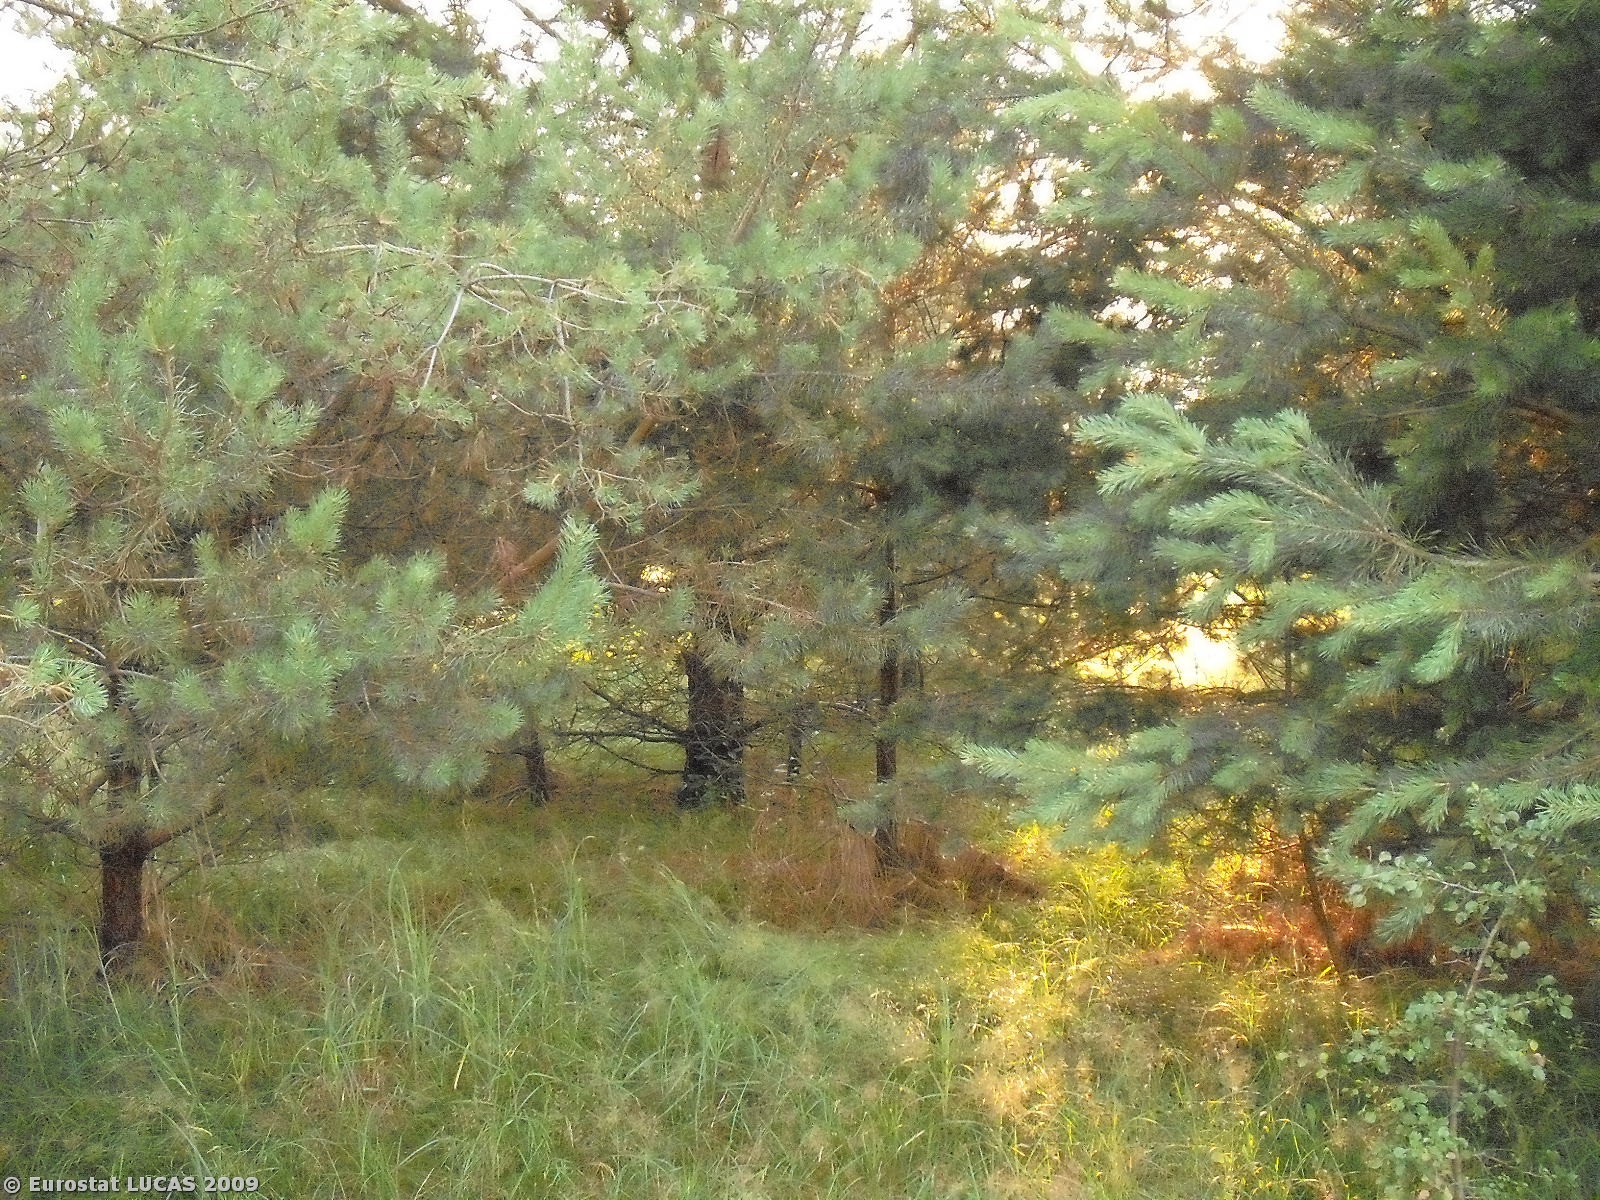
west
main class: Grassland
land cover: Grassland without tree/shrub cover
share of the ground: > 75 %
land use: Agriculture (excluding fallow land and kitchen gardens)
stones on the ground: < 10 %
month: July
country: PL
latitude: 51.0475
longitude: 20.8116
